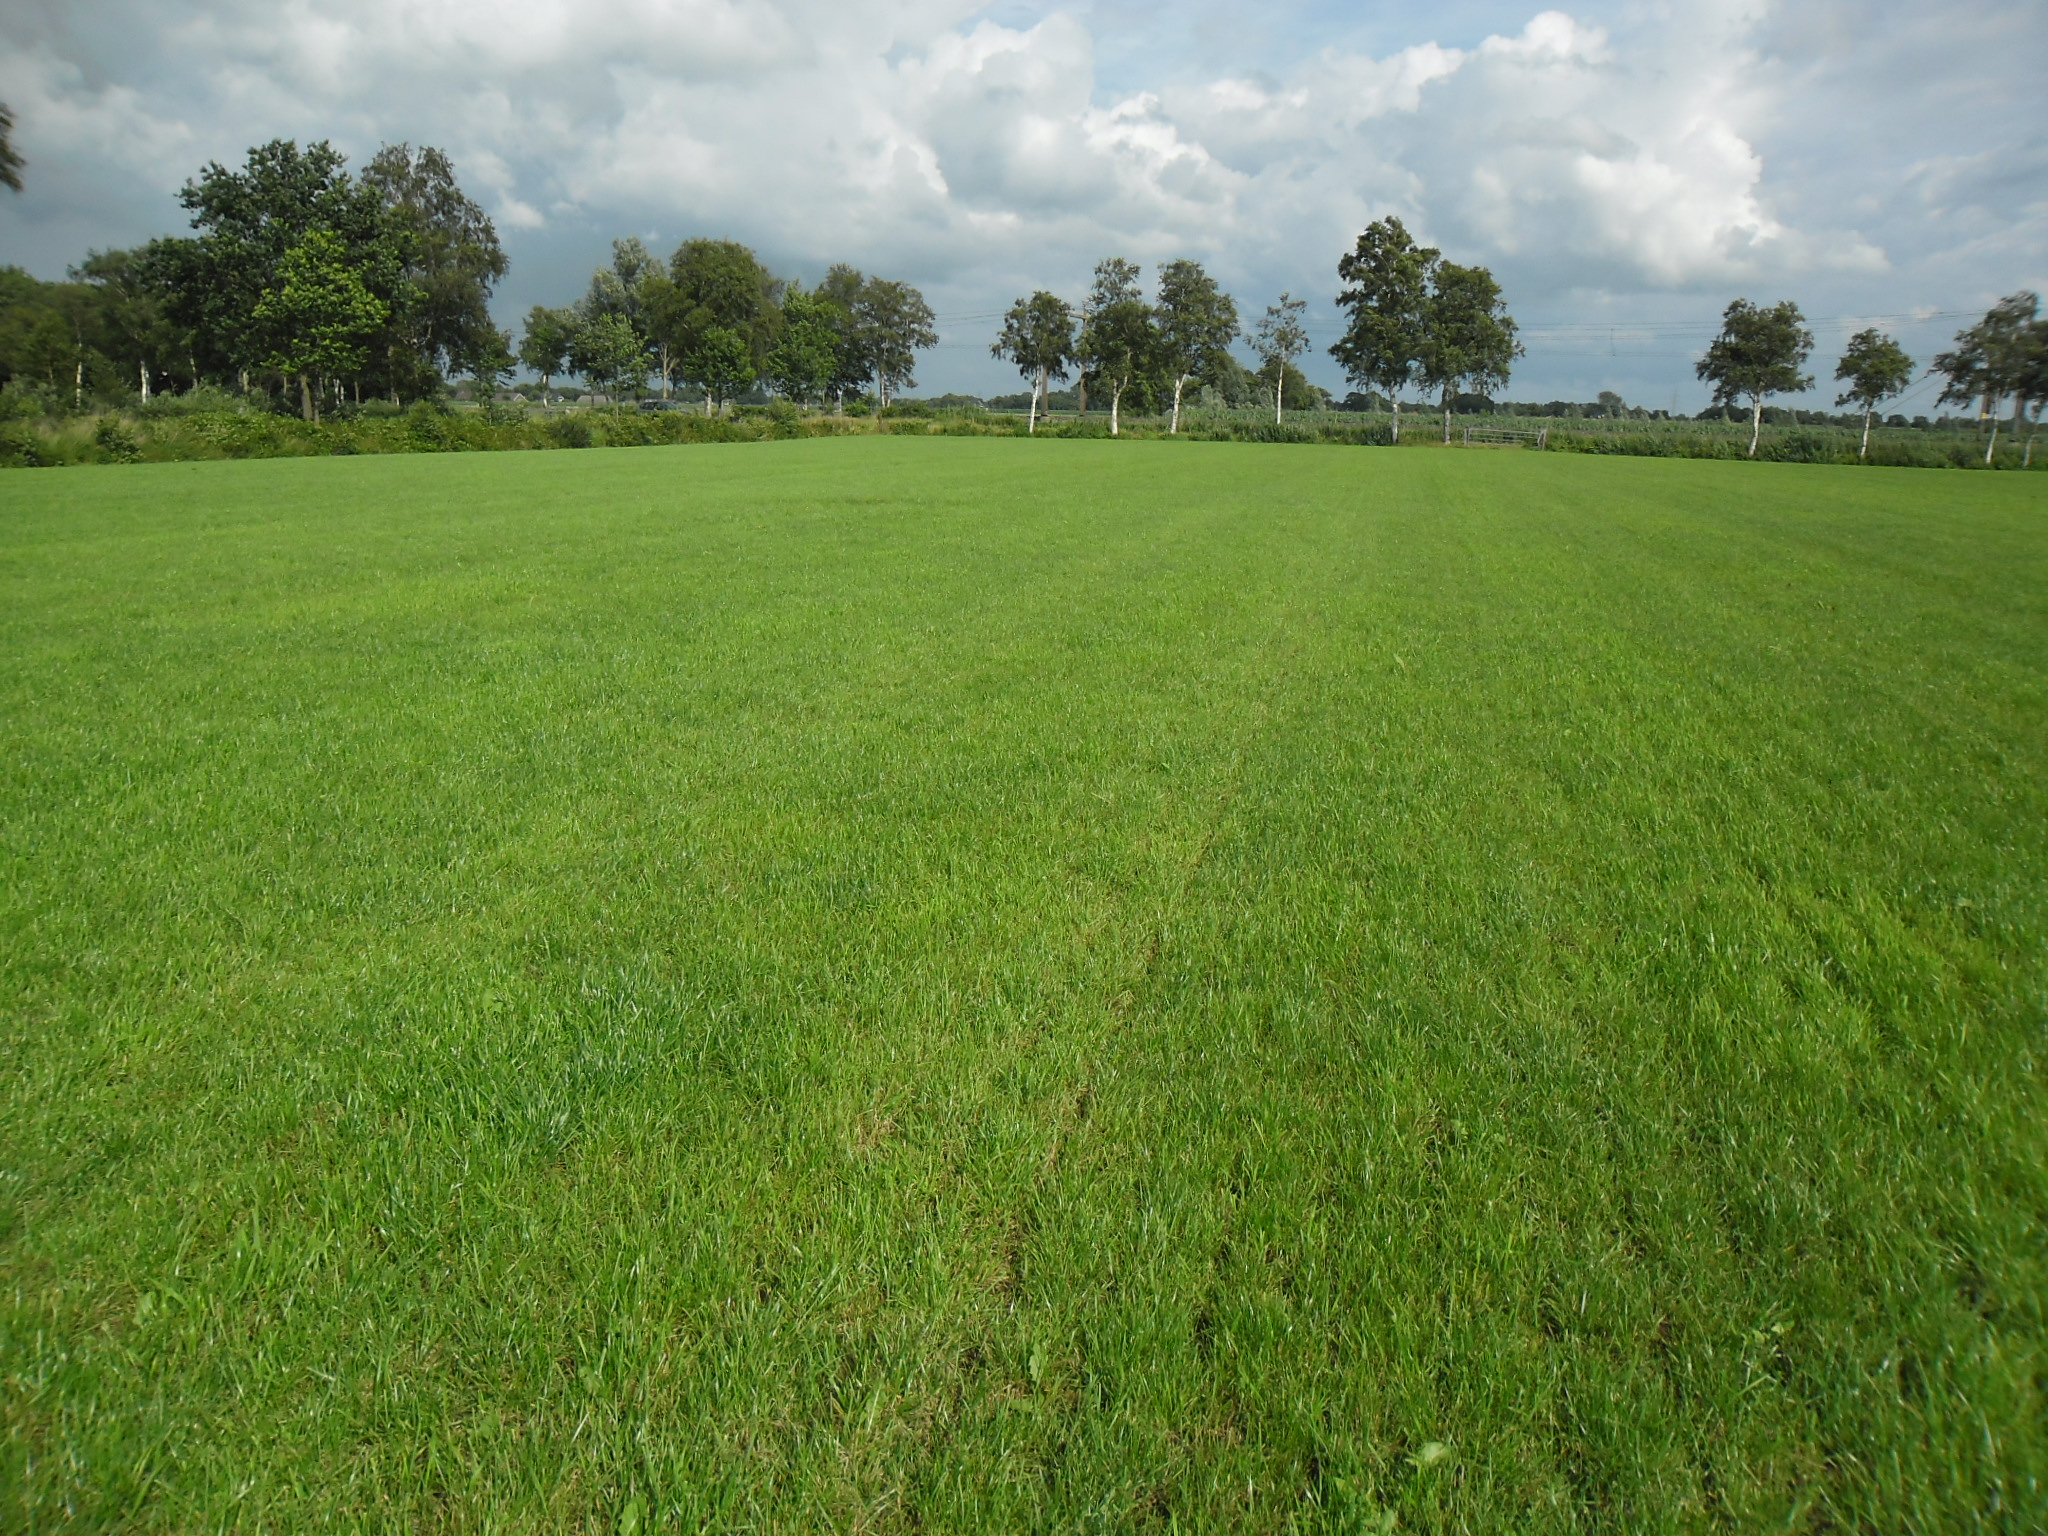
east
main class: Grassland
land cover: Grassland without tree/shrub cover
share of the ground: > 75 %
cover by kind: herbaceous plants 100 %
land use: Agriculture (excluding fallow land and kitchen gardens)
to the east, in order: Grassland without tree/shrub cover; Ditches and canals; Lines of trees; Paved roads, cycling and walking lanes; Spontaneously vegetated surfaces; Fences; Grass margins; Railways; Electric lines; Railways; Grass margins; Inland fresh running water; Grass margins; Tracks; Grass margins; Fences; Grassland without tree/shrub cover
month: July
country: NL
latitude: 52.6057
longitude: 6.2342
